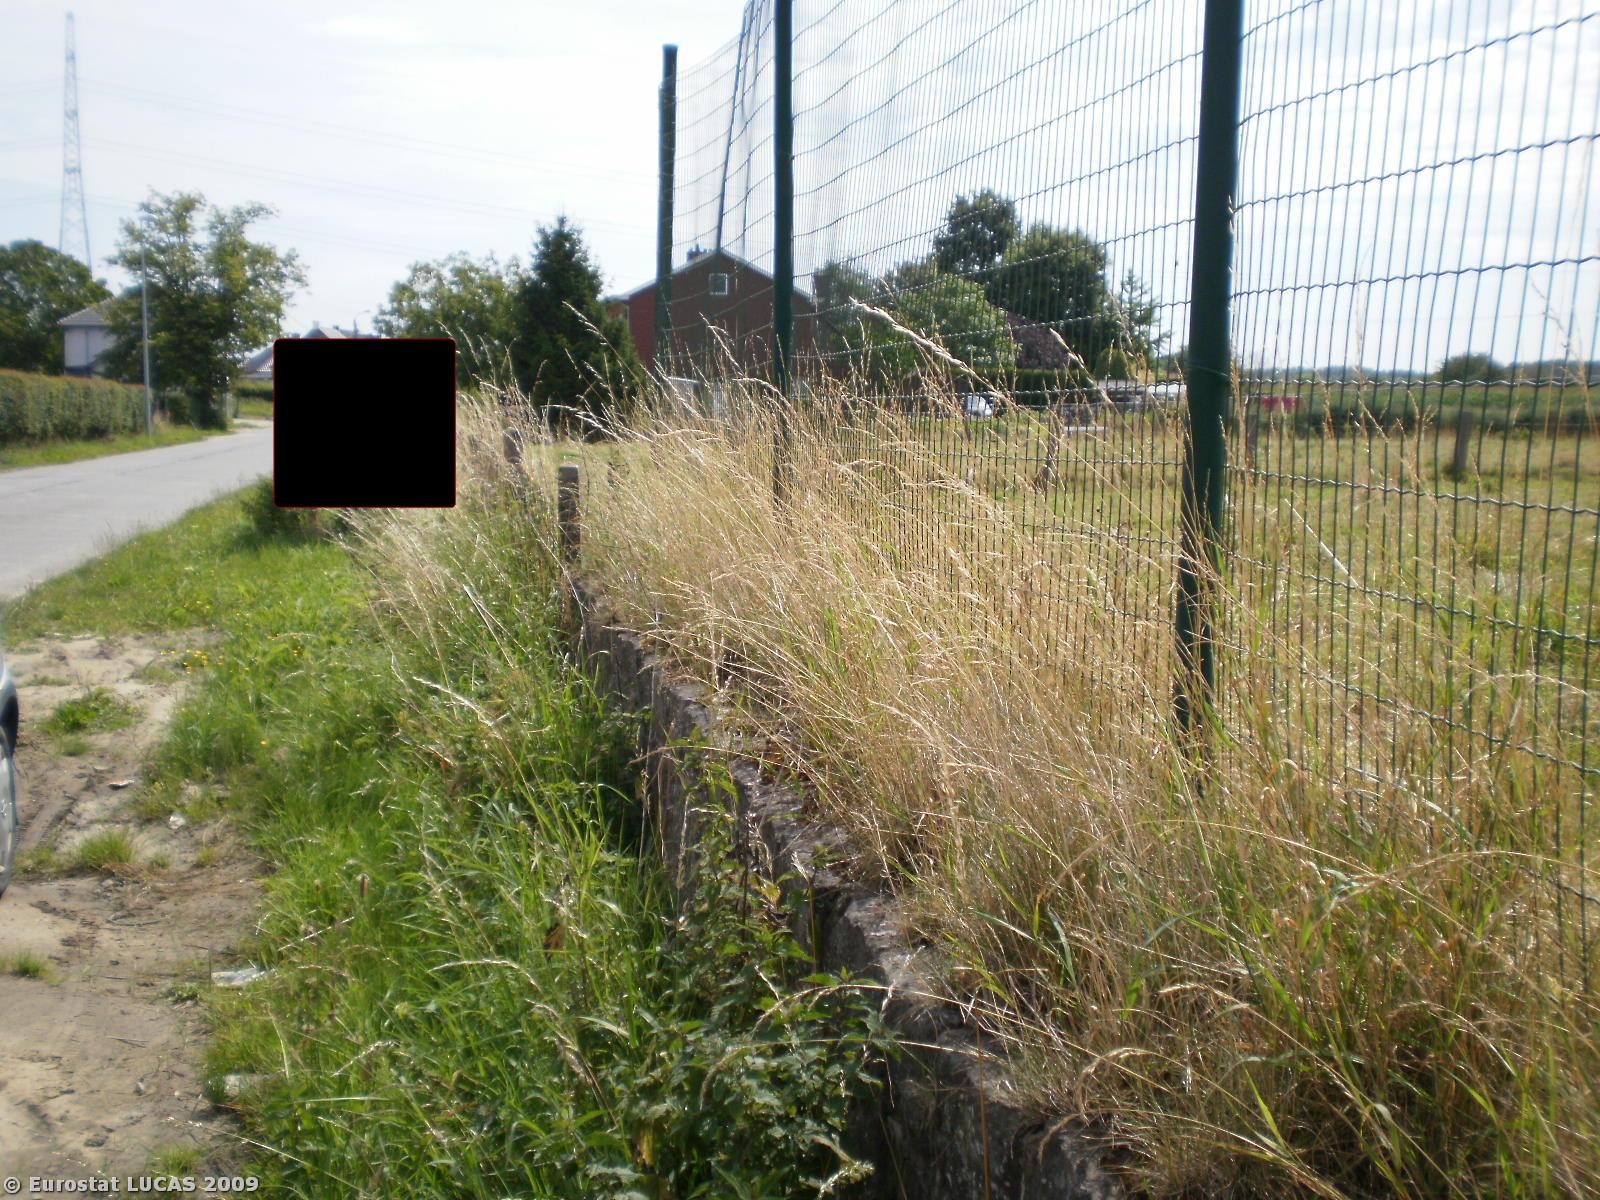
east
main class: Grassland
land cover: Grassland without tree/shrub cover
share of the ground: > 75 %
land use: Agriculture (excluding fallow land and kitchen gardens)
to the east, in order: Grassland without tree/shrub cover; Fences; Grassland without tree/shrub cover; Fences; Grassland without tree/shrub cover; Fences; Grass margins; Artificial constructions in urban areas
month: July
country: BE
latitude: 51.0470
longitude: 4.2179
